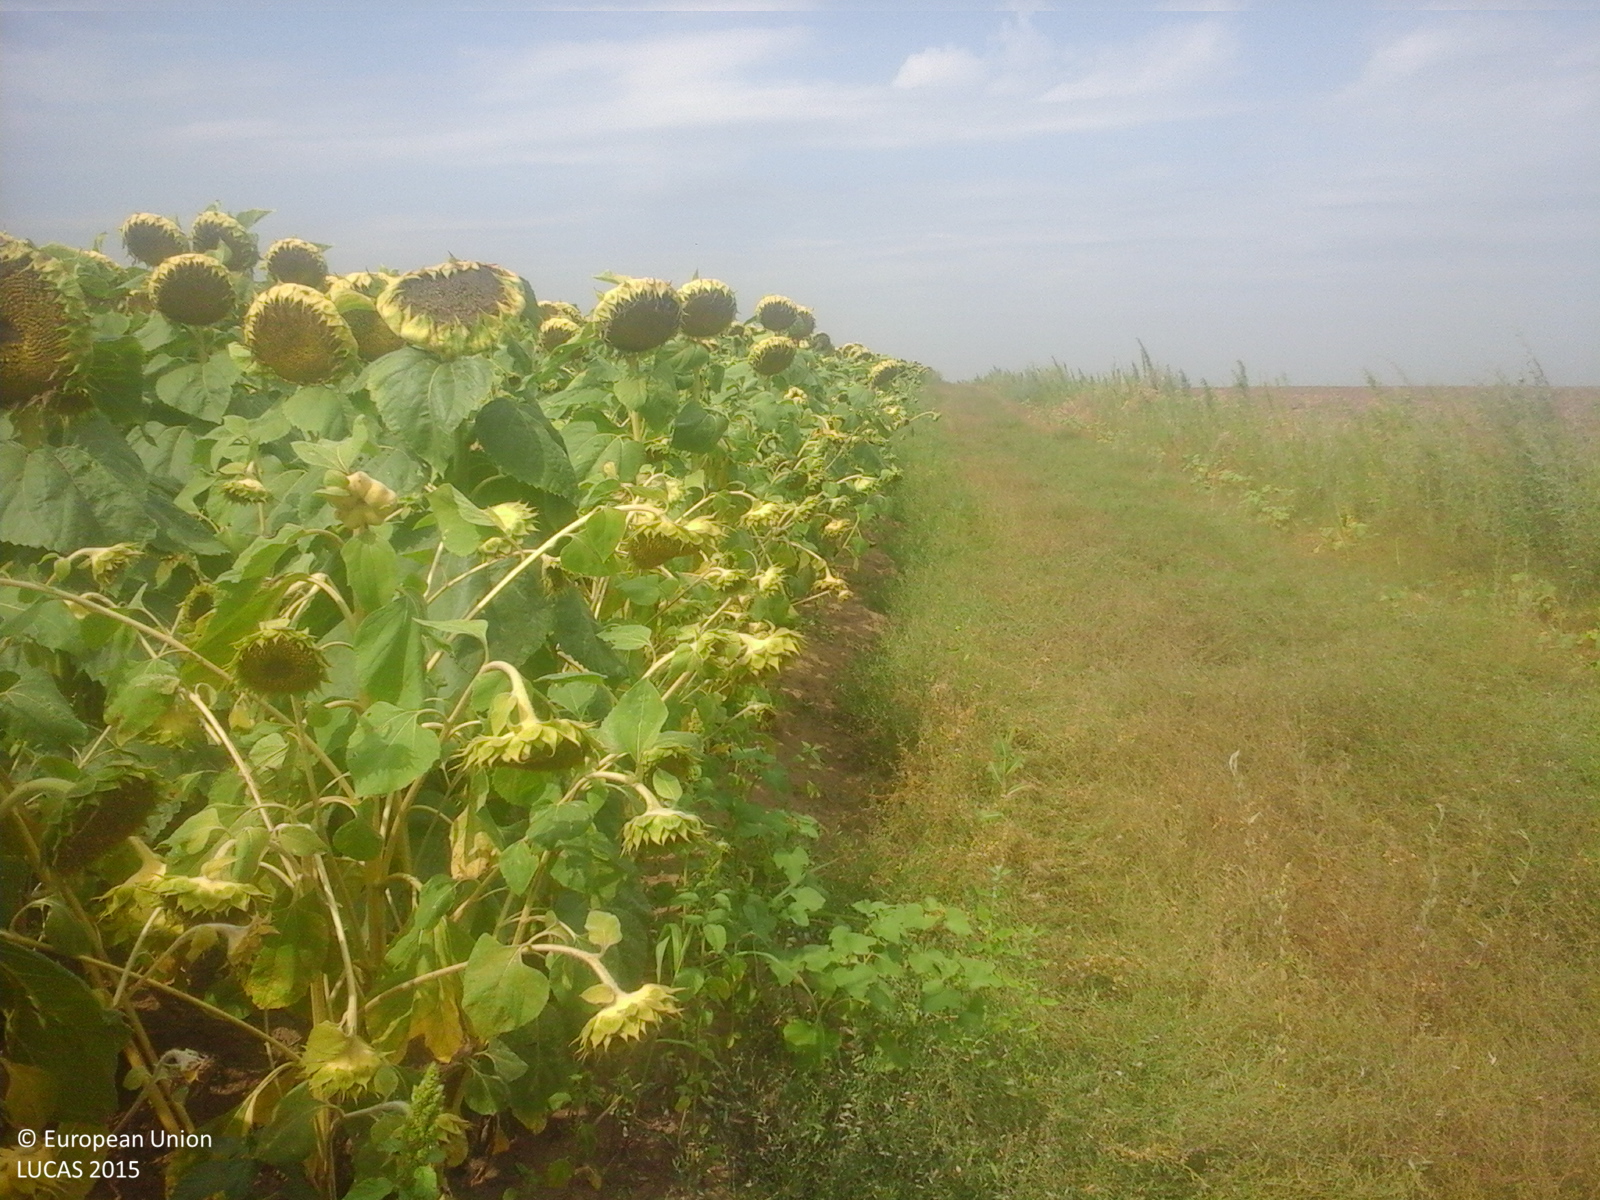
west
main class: Cropland
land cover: Sunflower
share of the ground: > 75 %
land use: Agriculture (excluding fallow land and kitchen gardens)
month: August
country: RO
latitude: 43.9231
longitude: 28.2042
